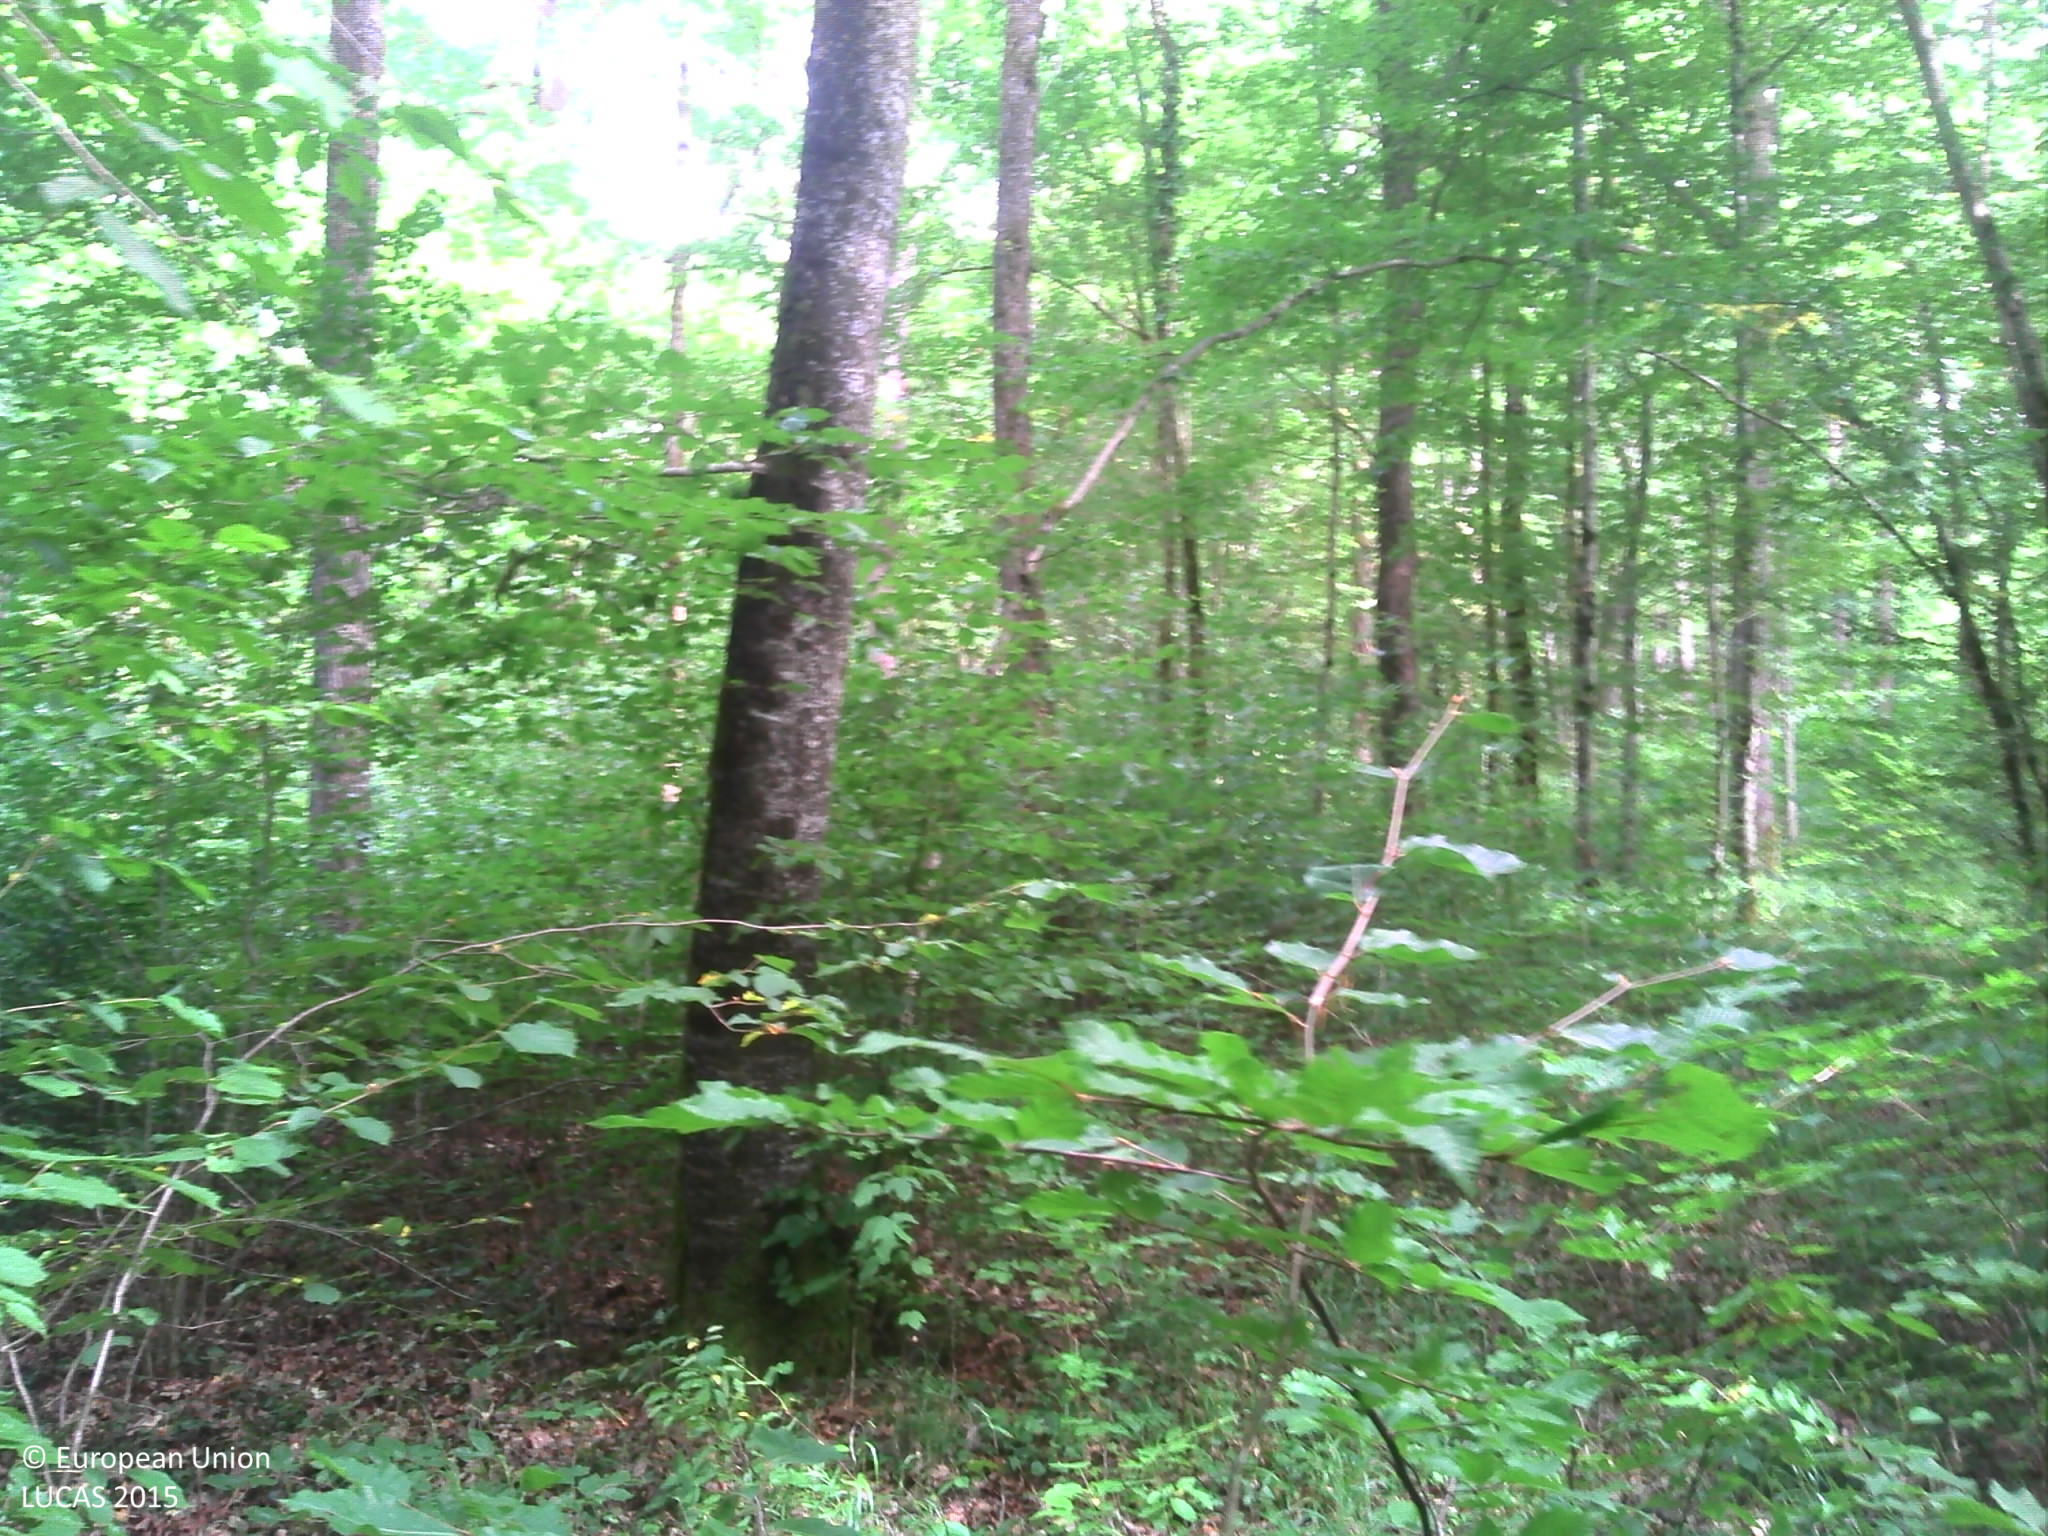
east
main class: Woodland
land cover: Broadleaved woodland
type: acidophilous oak and oak-birch forest
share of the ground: > 75 %
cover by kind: broadleaved forest trees 80 %, herbaceous plants 10 %, lichens and mosses 10 %
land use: Forestry
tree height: > 5 m
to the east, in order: Broadleaved woodland; Tracks; Broadleaved woodland
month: July
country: FR
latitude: 47.9110
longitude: 4.9819
